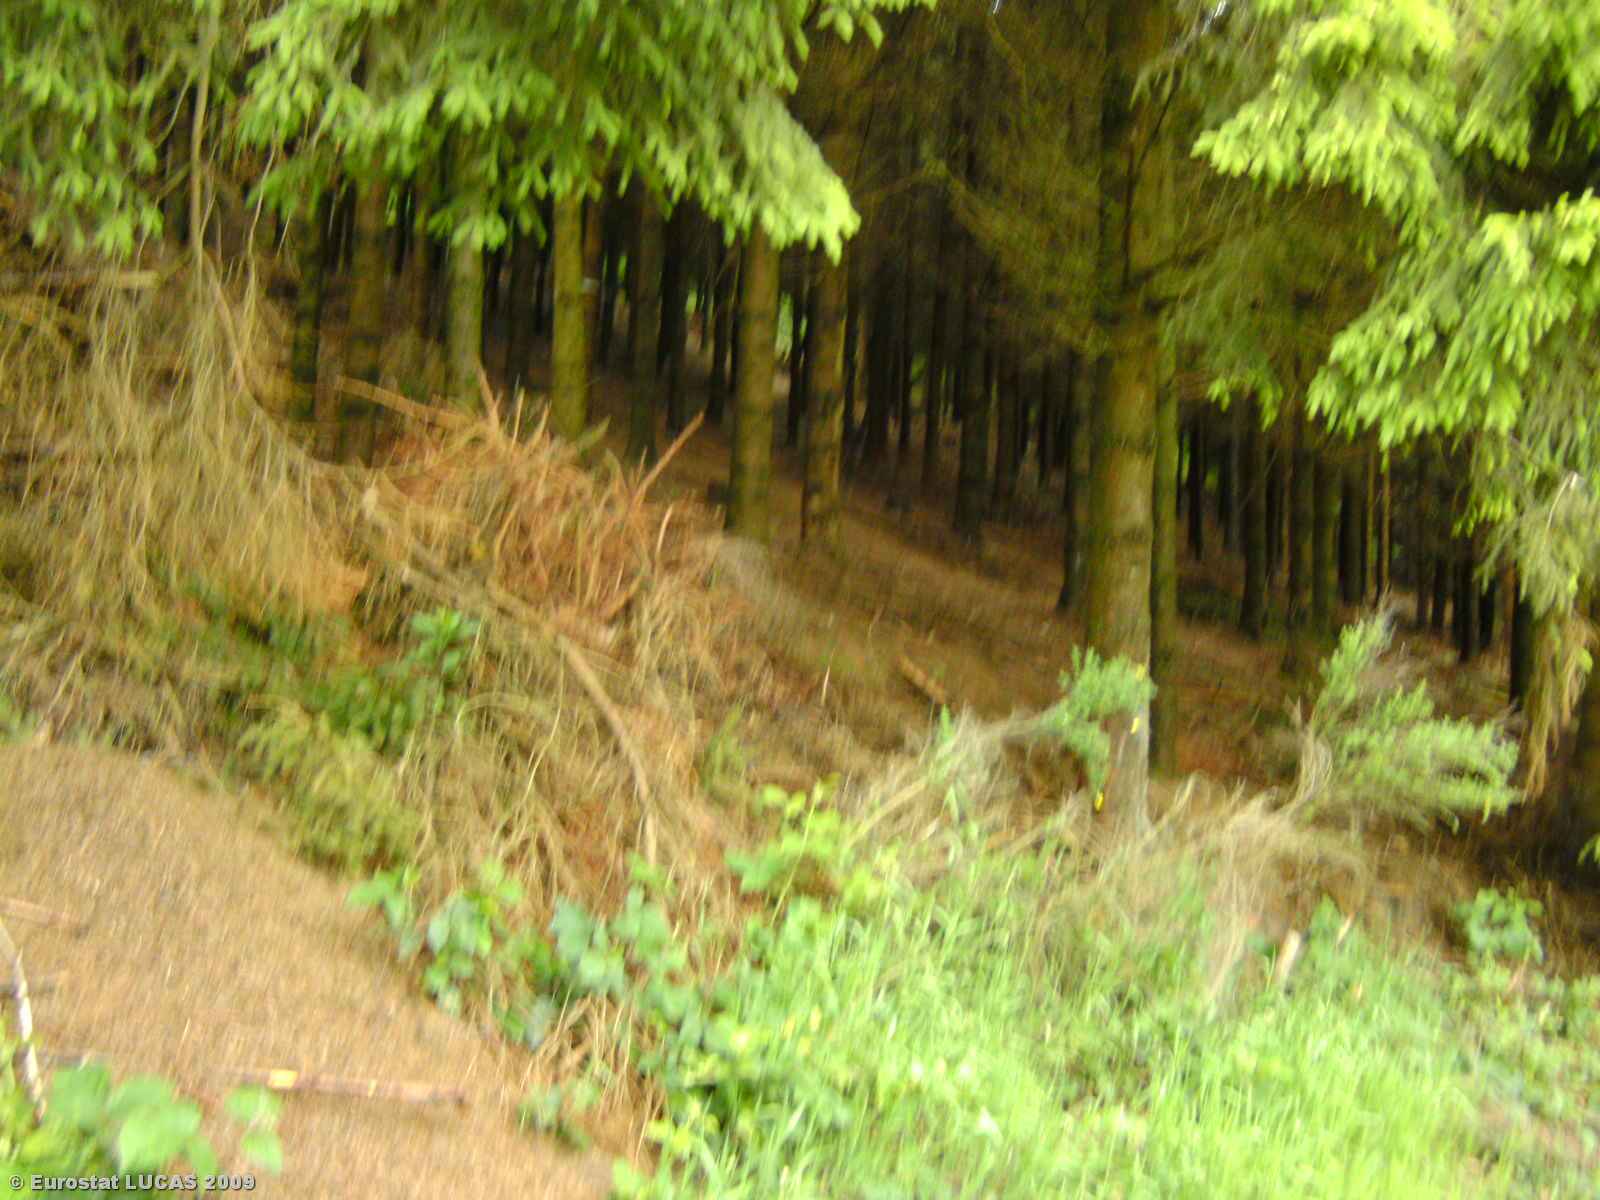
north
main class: Woodland
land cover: Coniferous woodland
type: exotic forest
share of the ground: > 75 %
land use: Forestry
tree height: > 5 m
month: June
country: LU
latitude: 49.9918
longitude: 6.1076
